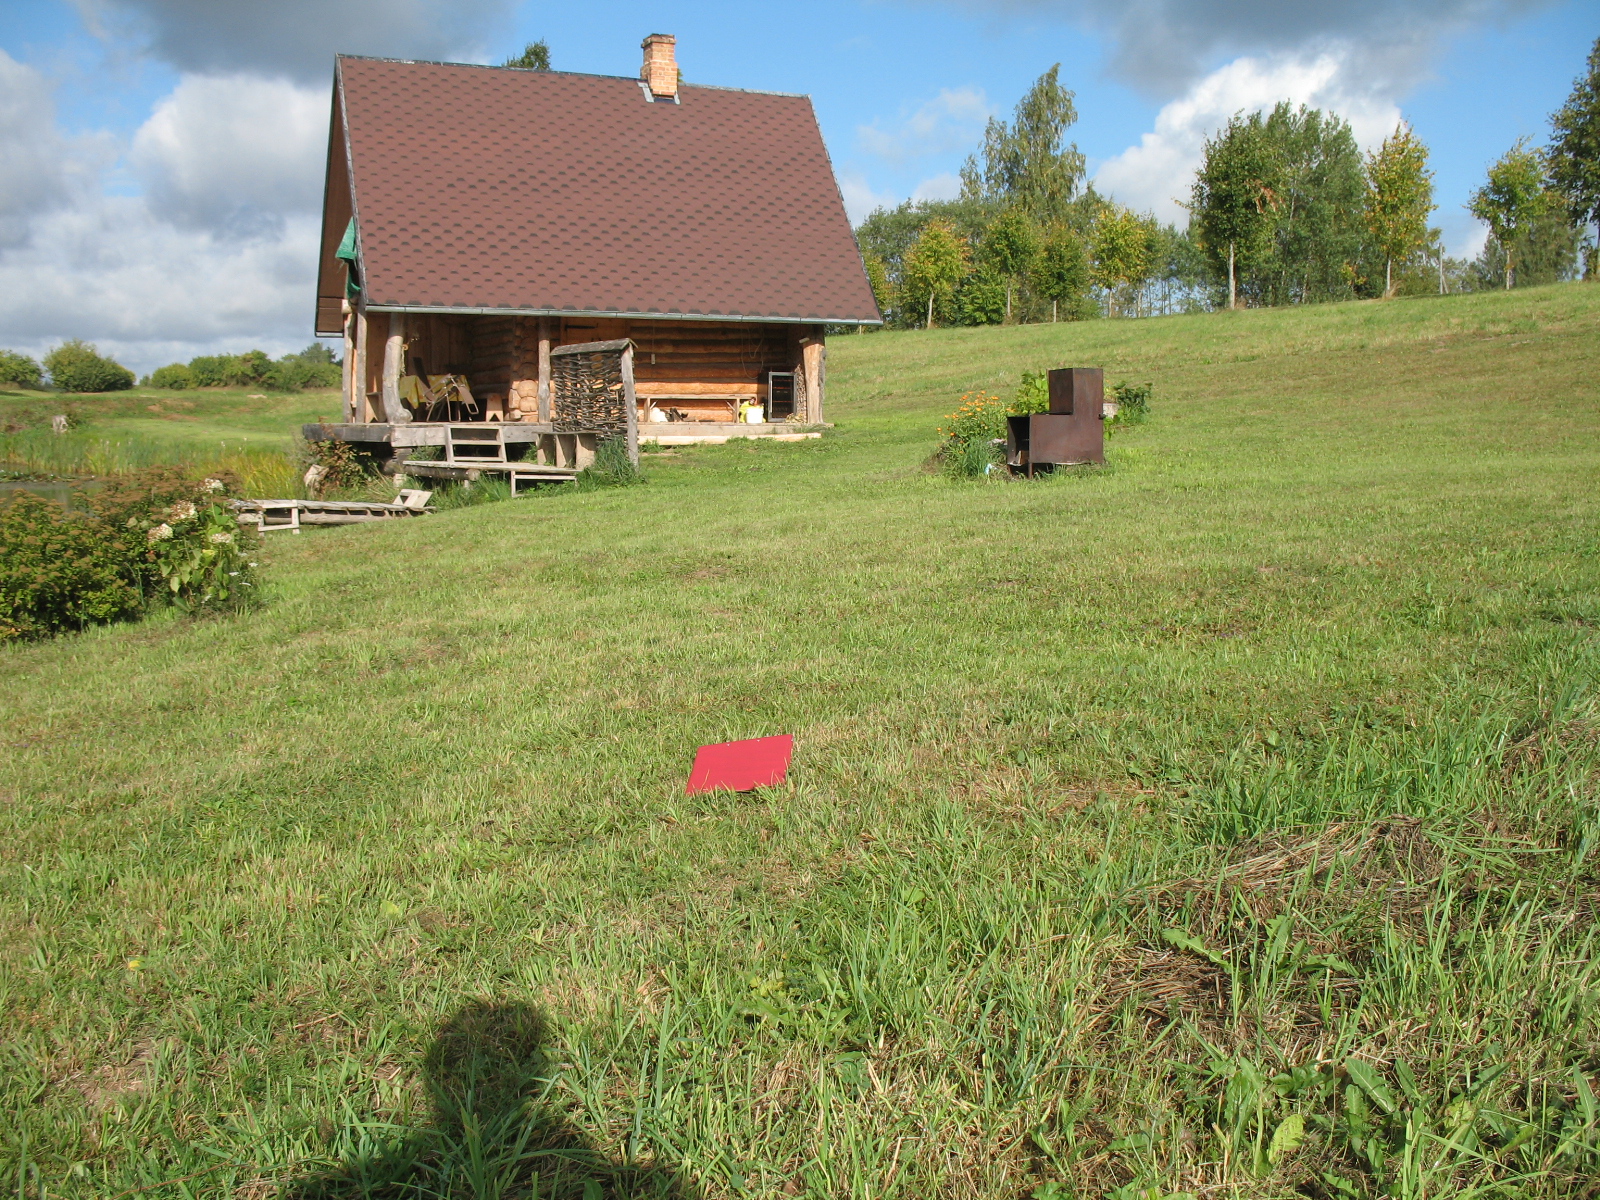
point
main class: Grassland
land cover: Grassland without tree/shrub cover
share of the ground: > 75 %
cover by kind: herbaceous plants 100 %
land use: Residential
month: August
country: LV
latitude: 56.2753
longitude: 26.0102
